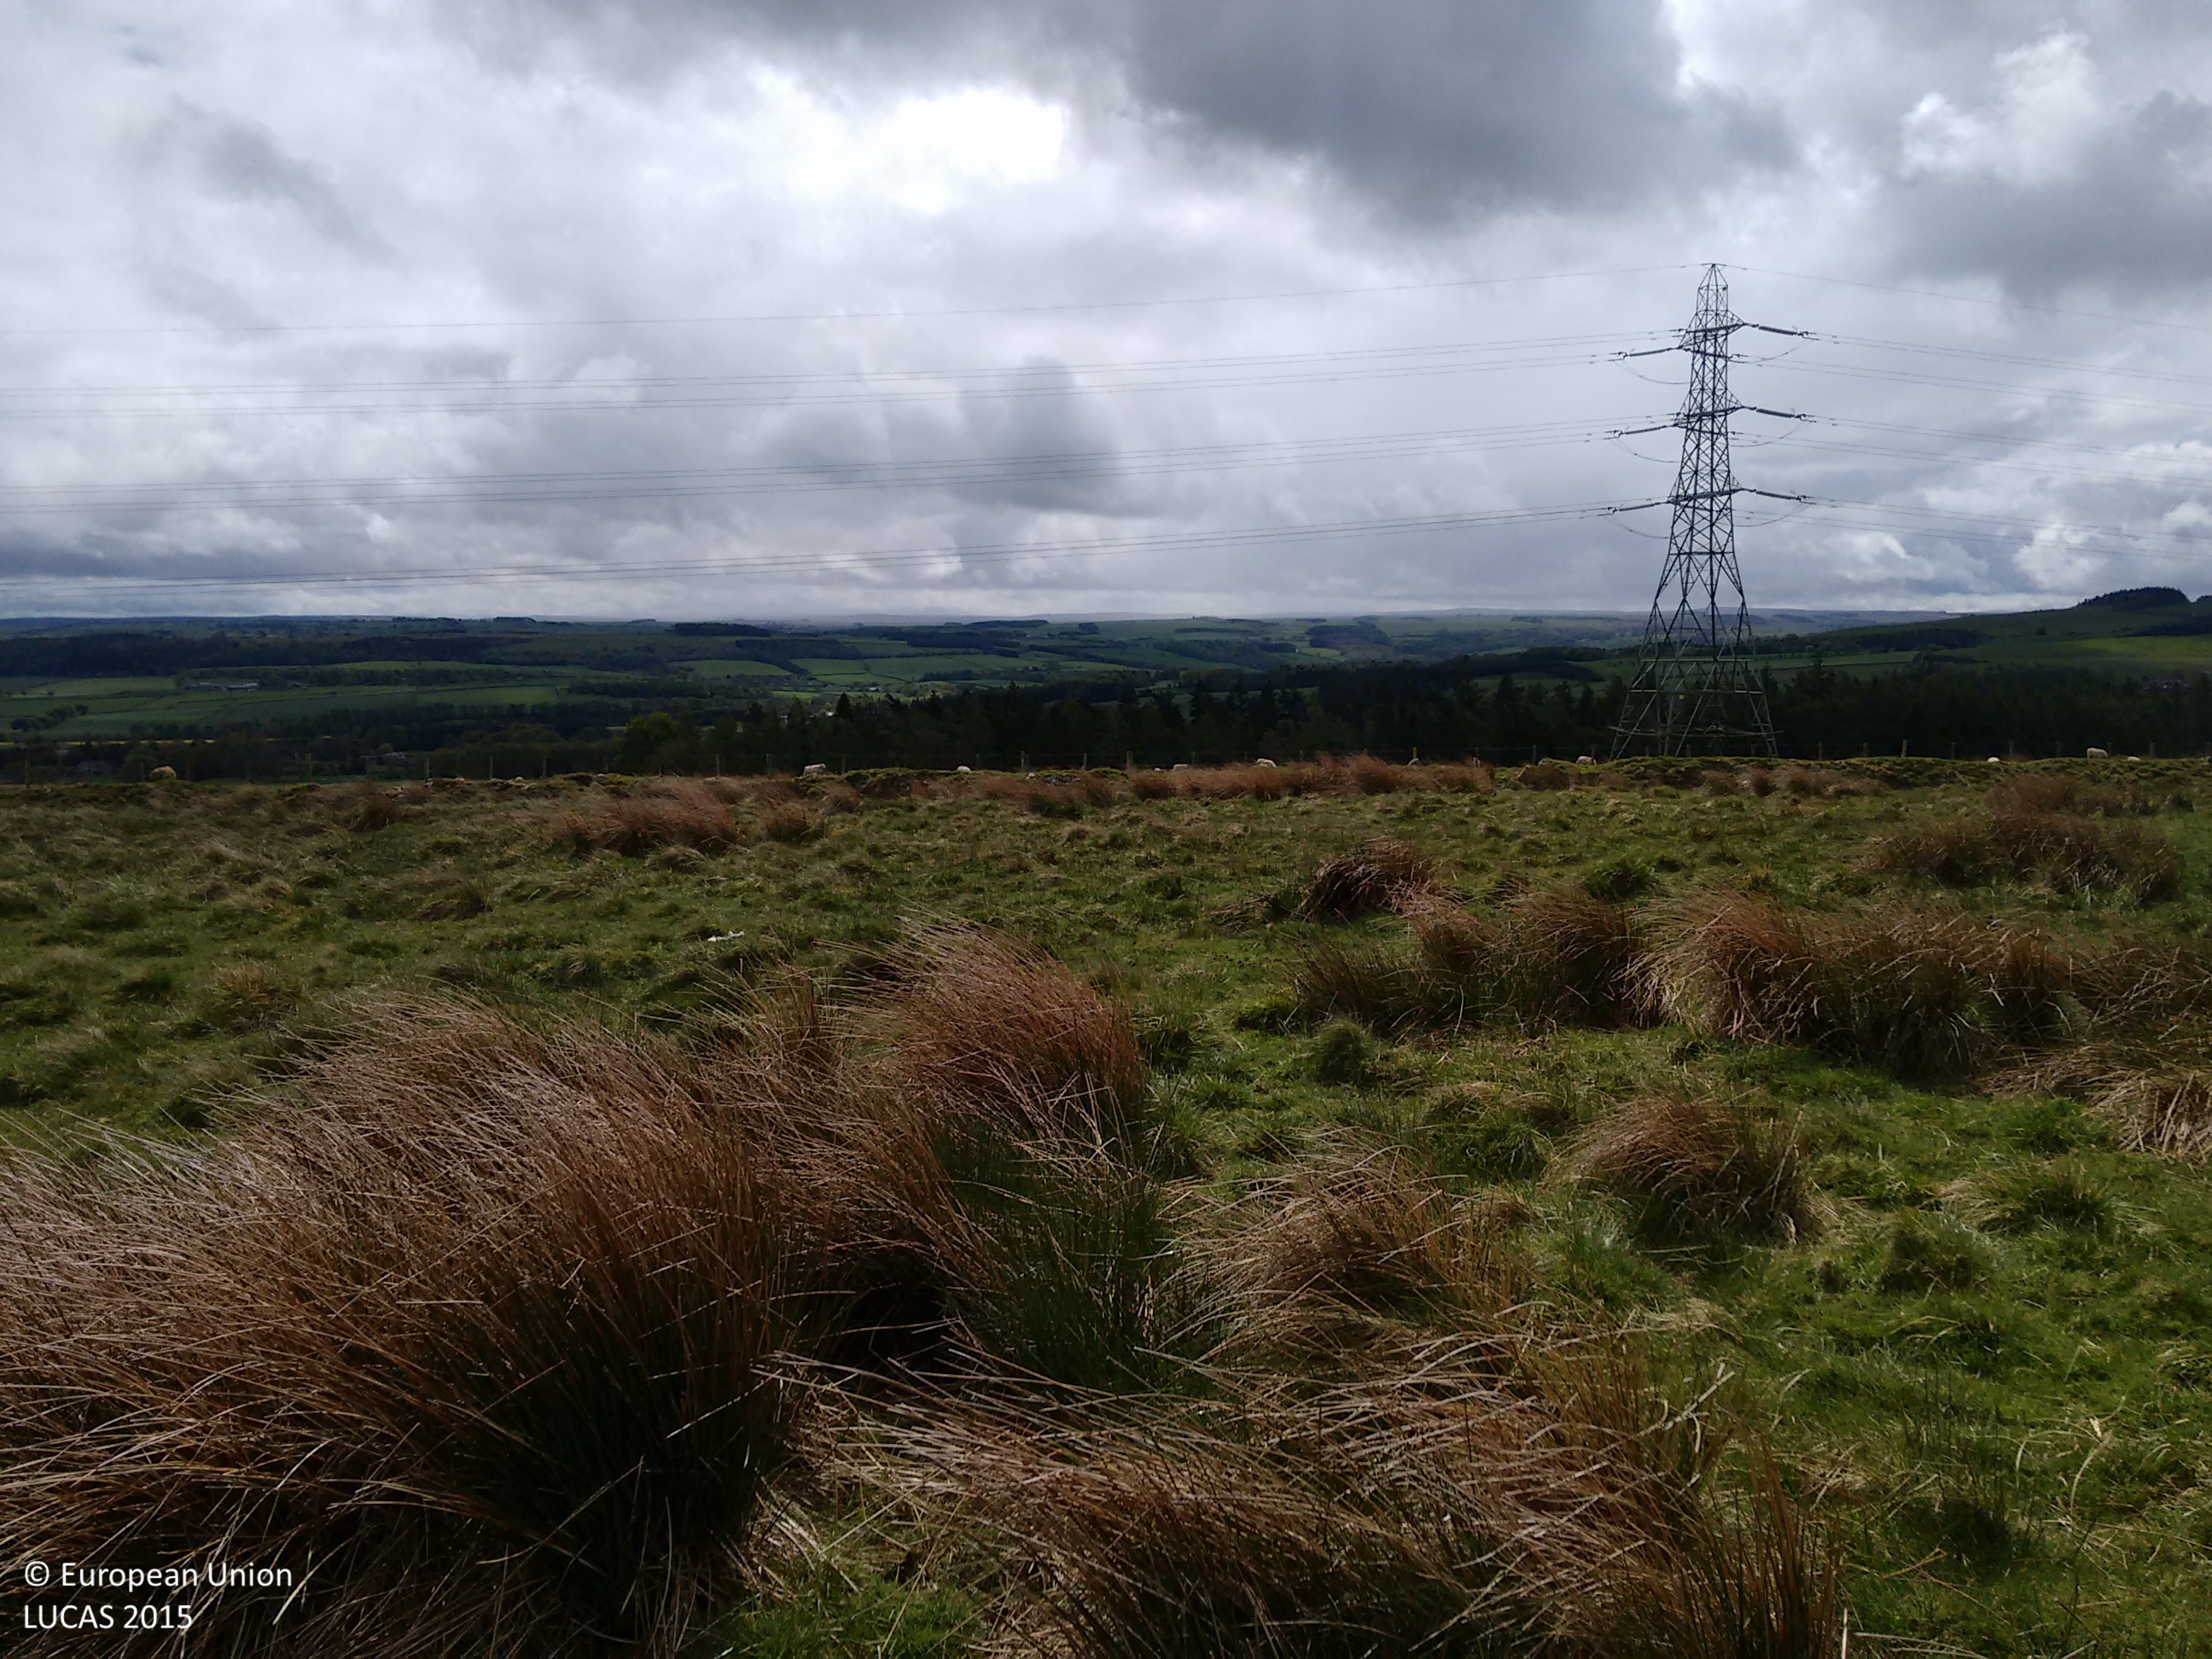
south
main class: Grassland
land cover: Grassland without tree/shrub cover
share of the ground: > 75 %
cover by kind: herbaceous plants 100 %
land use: Agriculture (excluding fallow land and kitchen gardens)
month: May
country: GB
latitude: 55.0194
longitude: -2.2105
